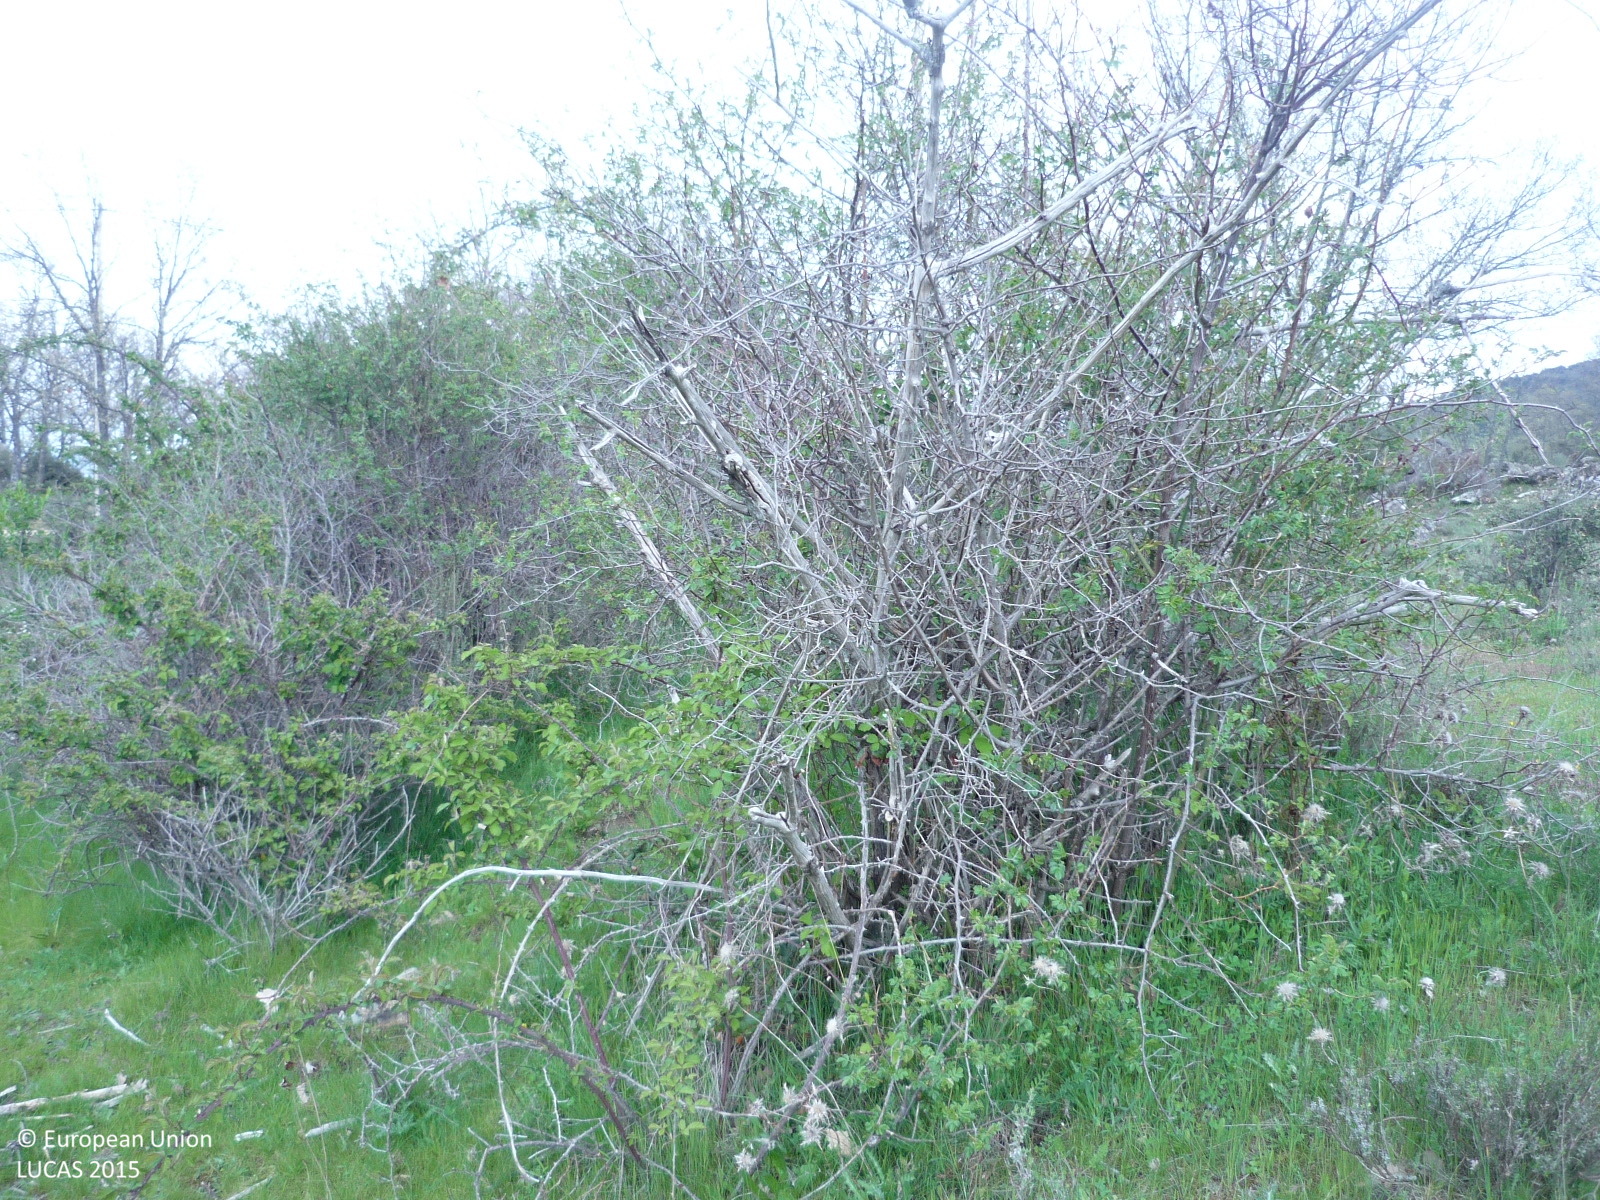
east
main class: Grassland
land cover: Grassland with sparse tree/shrub cover
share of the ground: > 75 %
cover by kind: herbaceous plants 85 %, shrubs 10 %, broadleaved forest trees 5 %
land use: Agriculture (excluding fallow land and kitchen gardens)
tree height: < 5 m
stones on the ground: < 10 %
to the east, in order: Grassland with sparse tree/shrub cover; Tracks; Grassland with sparse tree/shrub cover; Broadleaved woodland; Grassland with sparse tree/shrub cover; Fences; Grassland with sparse tree/shrub cover; Artificial constructions in urban areas; Grassland with sparse tree/shrub cover; Fences; Grassland with sparse tree/shrub cover
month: April
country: ES
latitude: 40.9505
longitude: -3.6938
